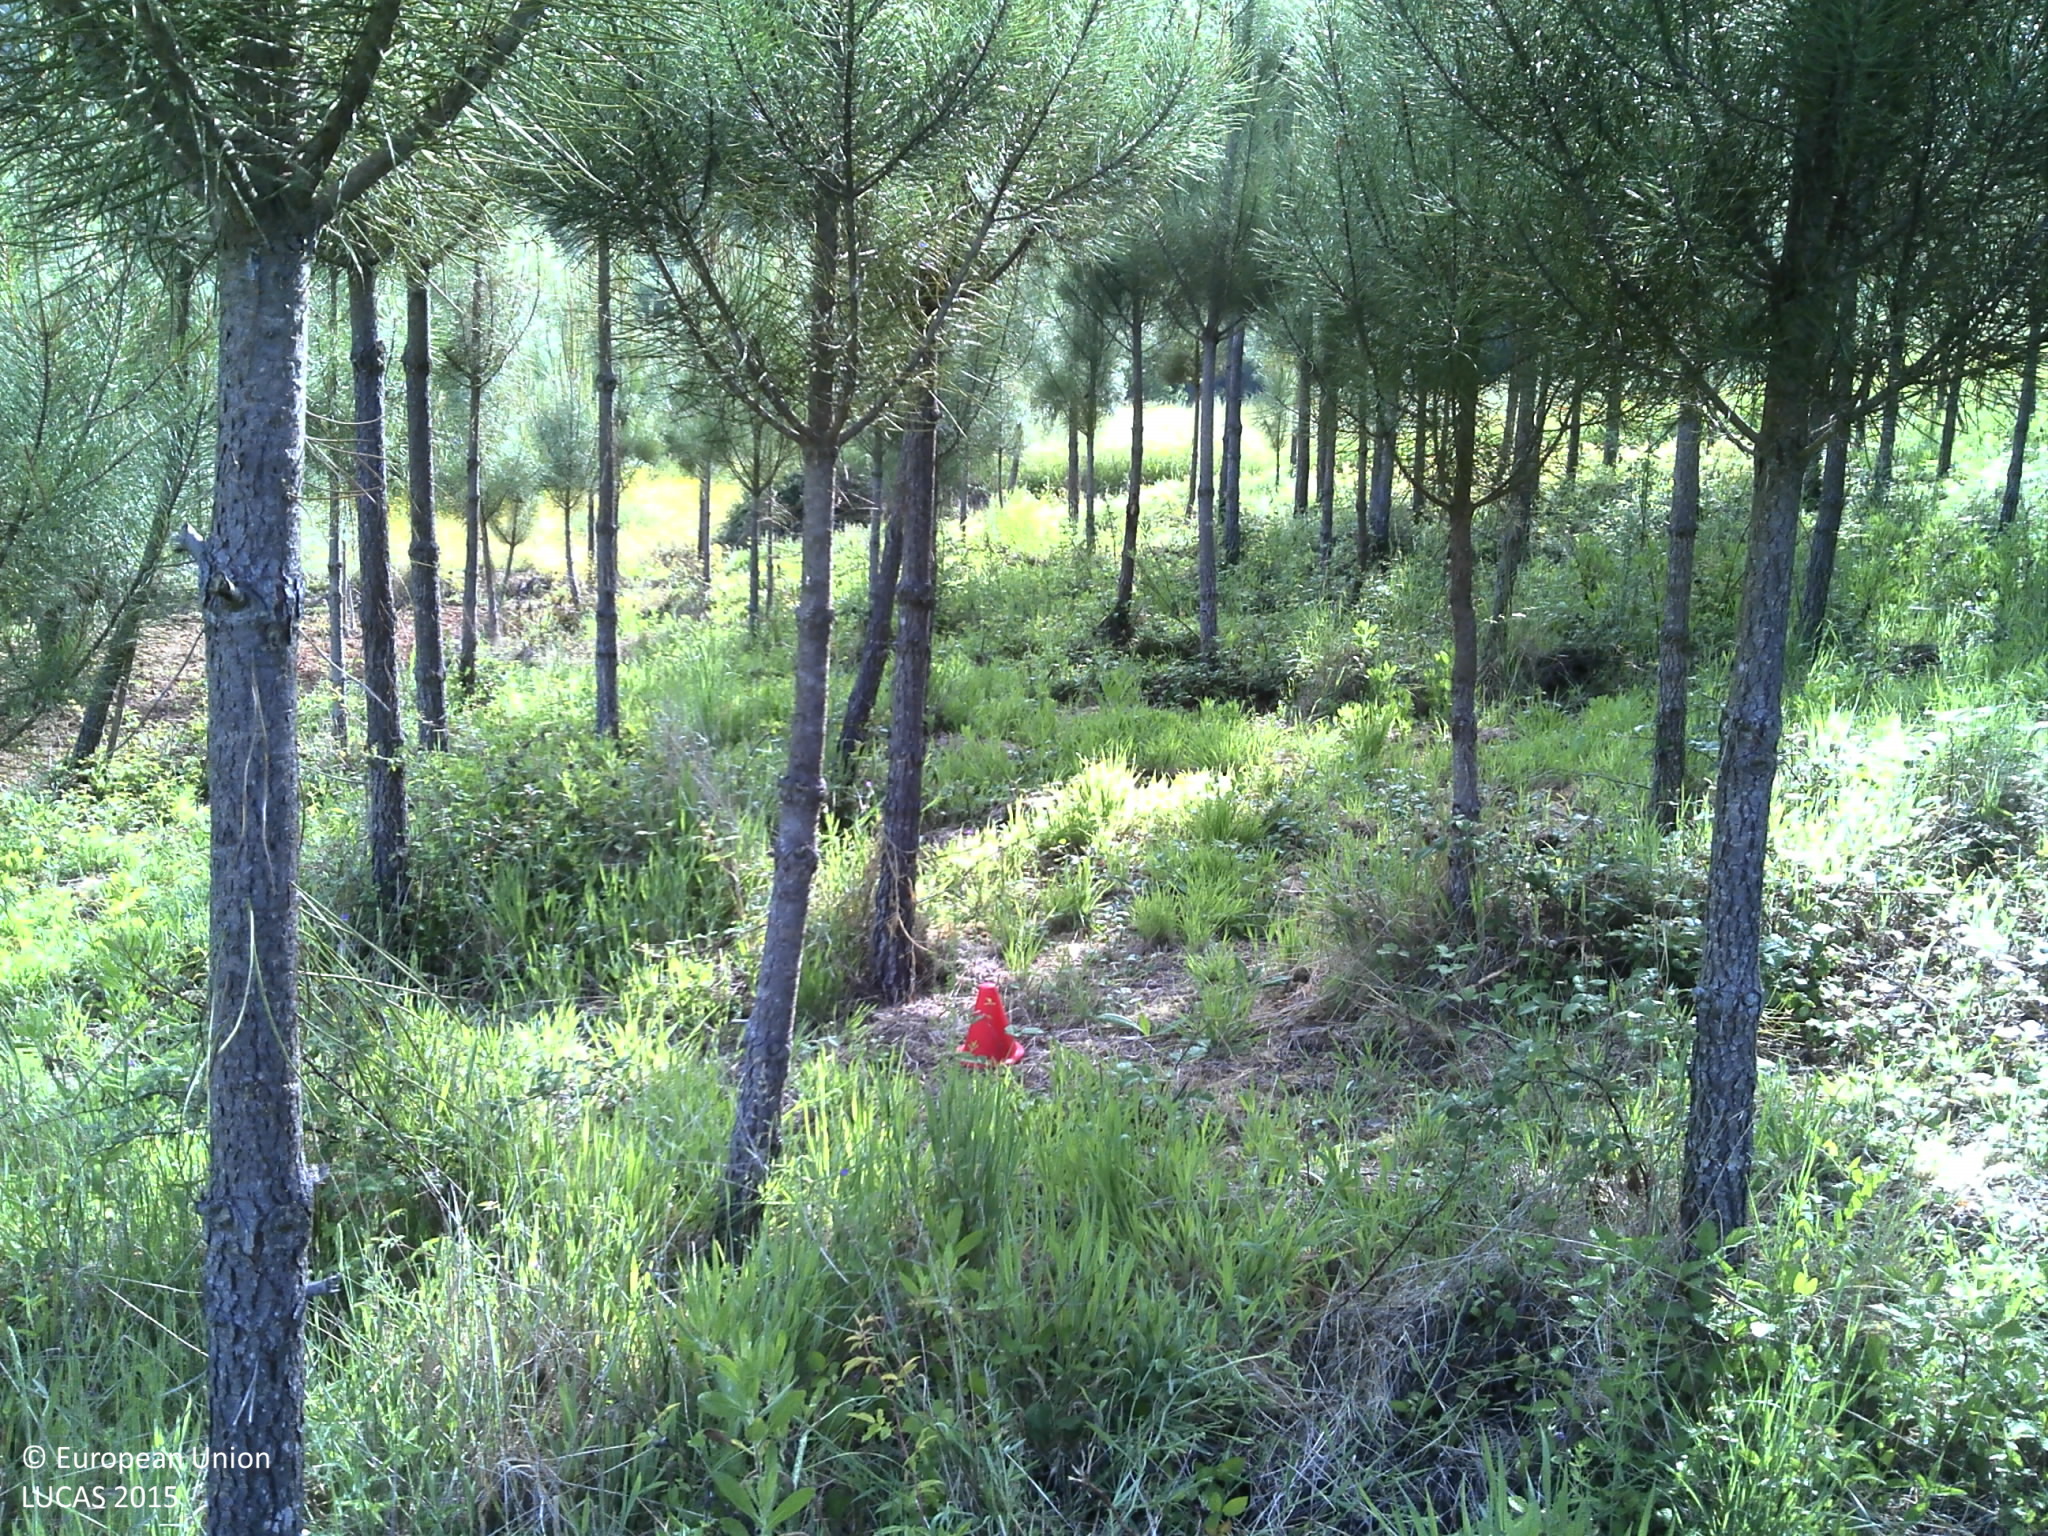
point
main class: Woodland
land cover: Pine dominated coniferous woodland
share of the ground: 50 - 75 %
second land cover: Grassland without tree/shrub cover
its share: 25 - 50 %
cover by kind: coniferous forest trees 85 %, herbaceous plants 15 %
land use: Forestry
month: May
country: PT
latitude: 39.6776
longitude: -8.3886
